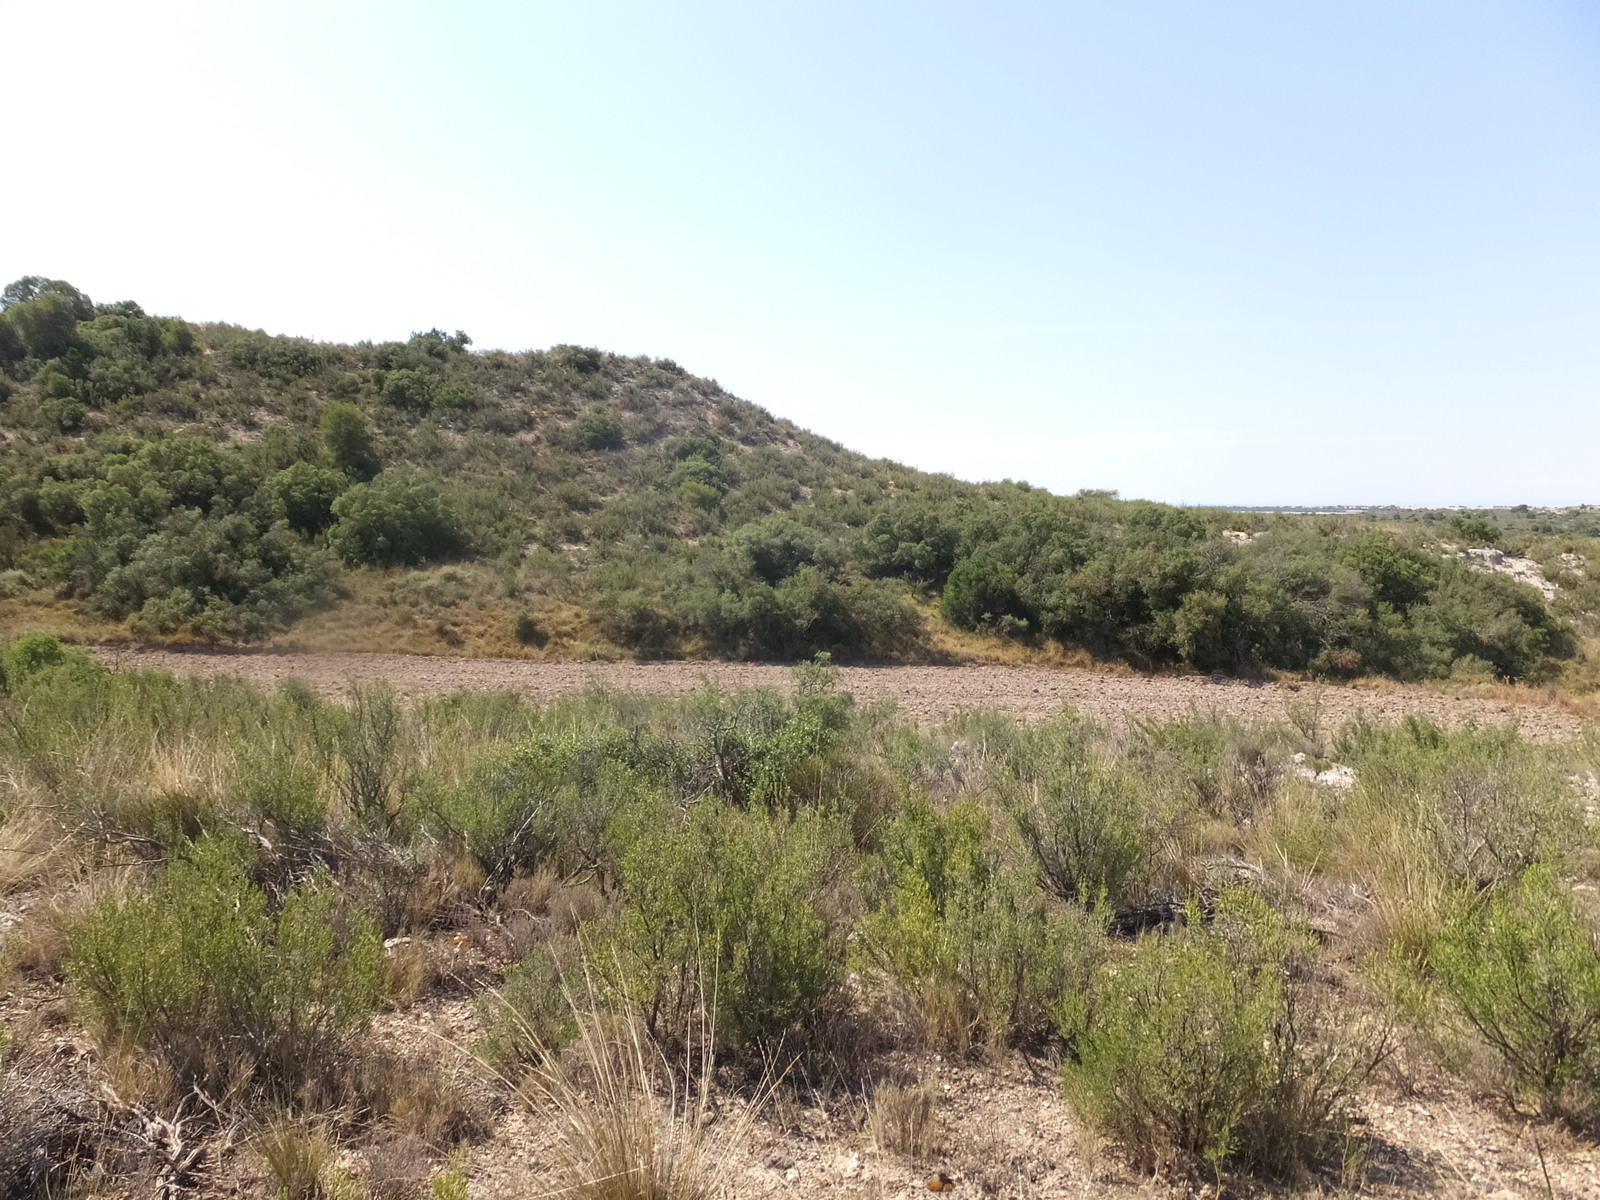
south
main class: Shrubland
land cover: Shrubland with sparse tree cover
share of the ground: > 75 %
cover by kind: shrubs 70 %, herbaceous plants 25 %, coniferous forest trees 5 %
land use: Semi-natural and natural areas not in use
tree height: < 5 m
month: June
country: ES
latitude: 41.3843
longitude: -0.0949
